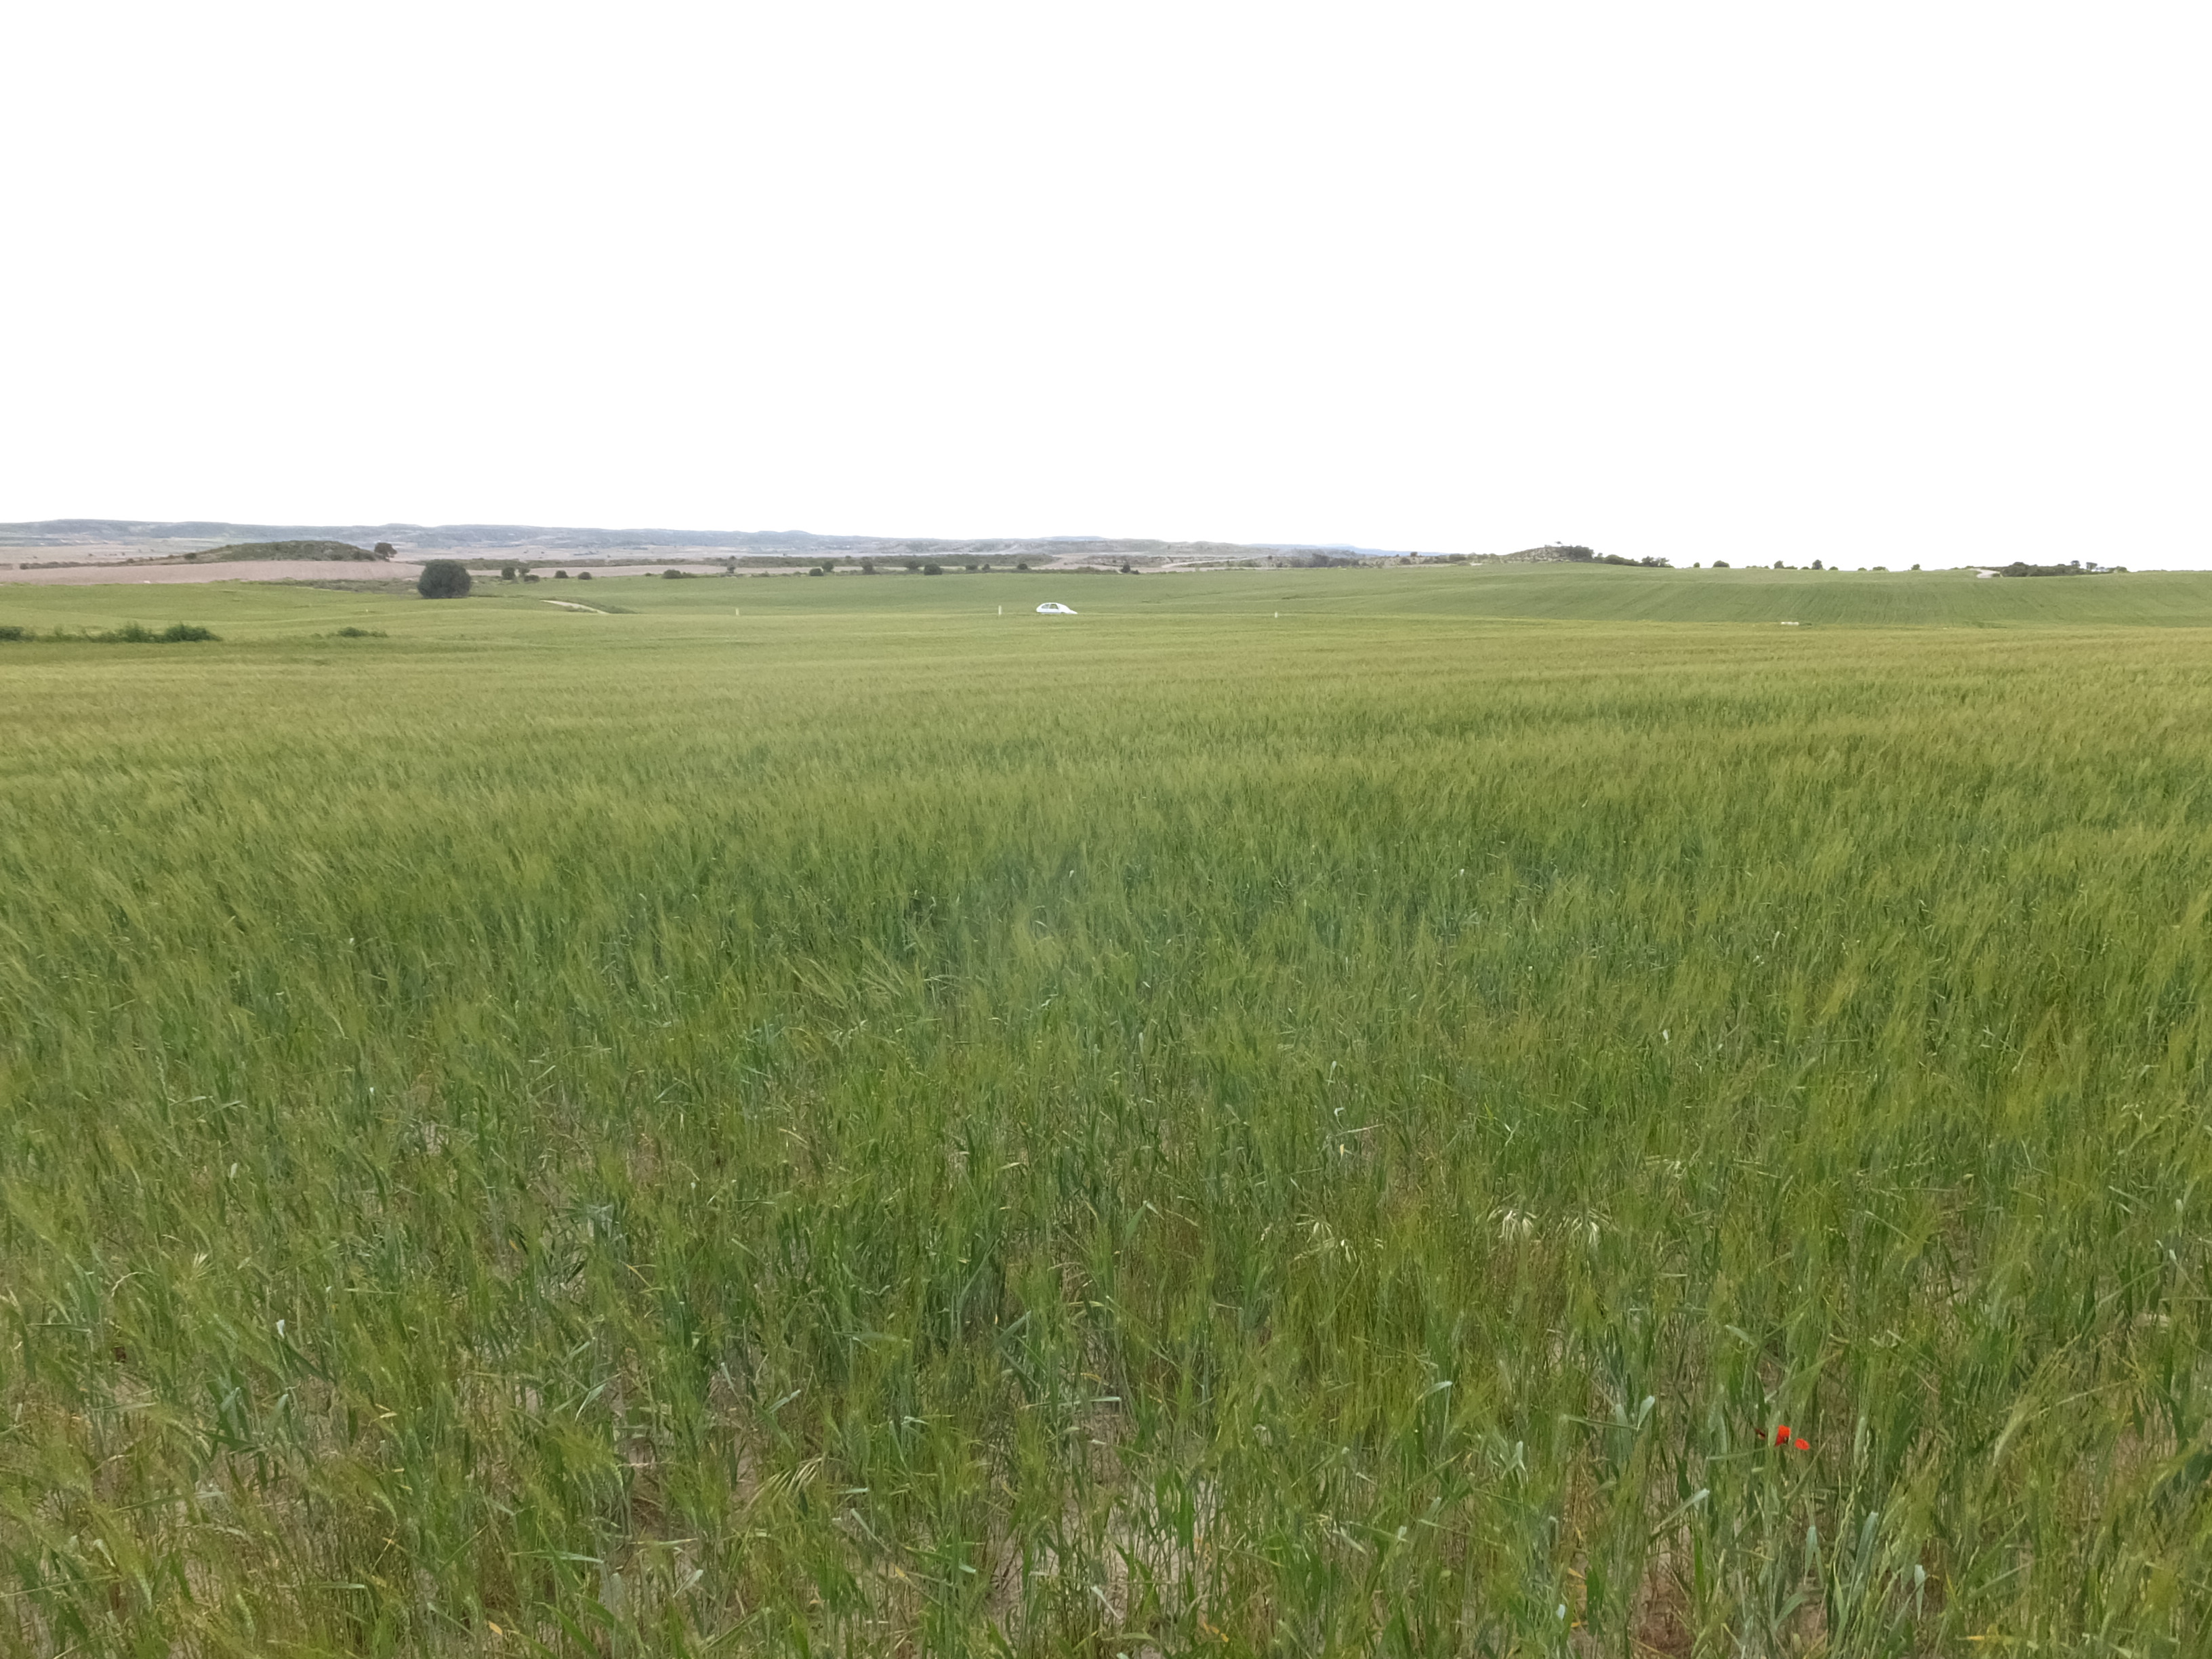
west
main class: Cropland
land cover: Durum wheat
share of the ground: > 75 %
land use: Agriculture (excluding fallow land and kitchen gardens)
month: May
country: ES
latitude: 41.6528
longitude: -0.1392
